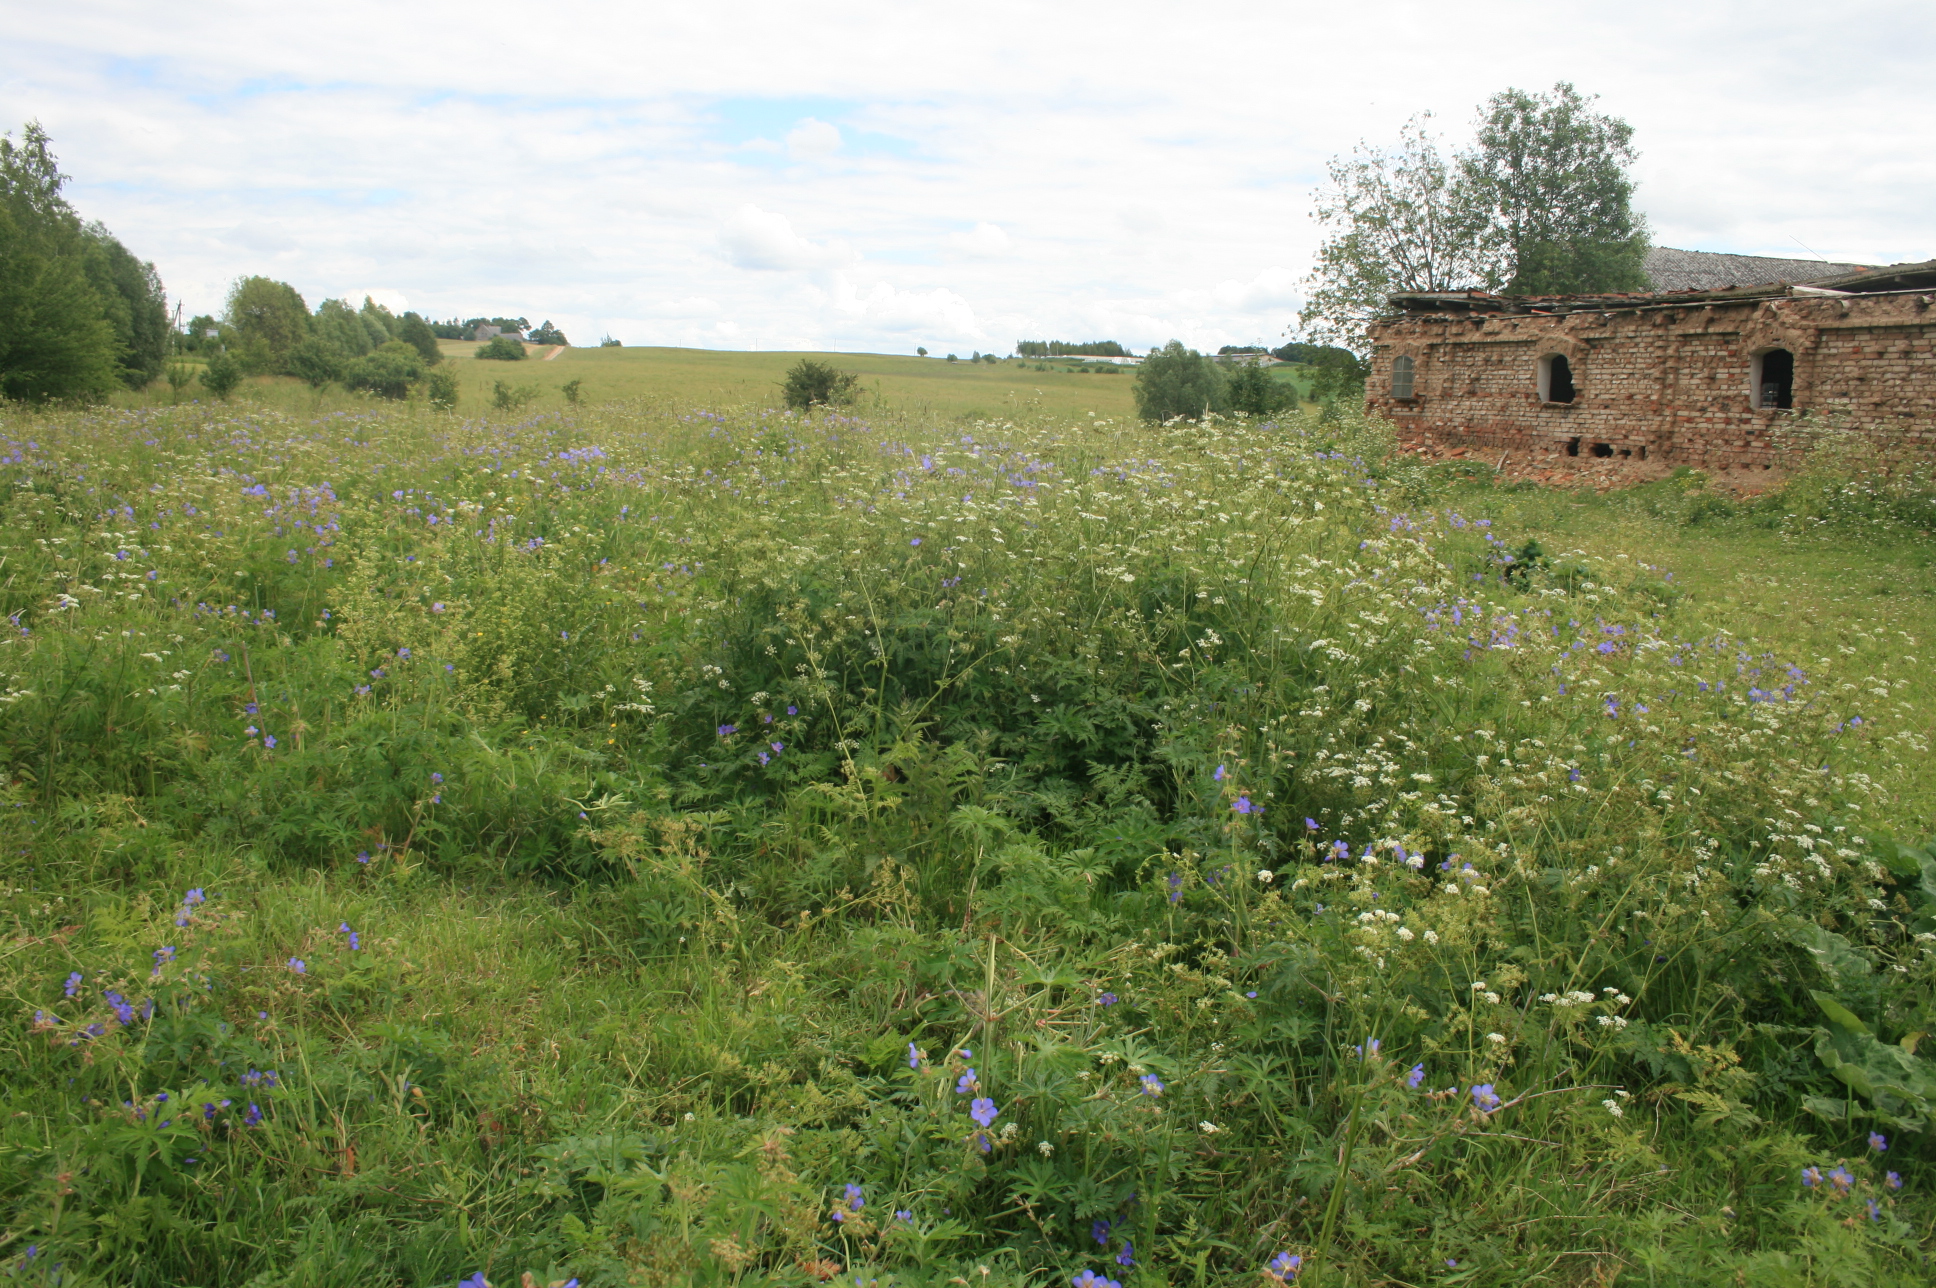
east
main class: Grassland
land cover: Spontaneously vegetated surfaces
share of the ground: > 75 %
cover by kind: herbaceous plants 100 %
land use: Agriculture (excluding fallow land and kitchen gardens)
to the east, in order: Spontaneously vegetated surfaces; Grassland without tree/shrub cover; Fences; Grassland with sparse tree/shrub cover; Grassland without tree/shrub cover
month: June
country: LT
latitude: 55.1612
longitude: 22.0626
